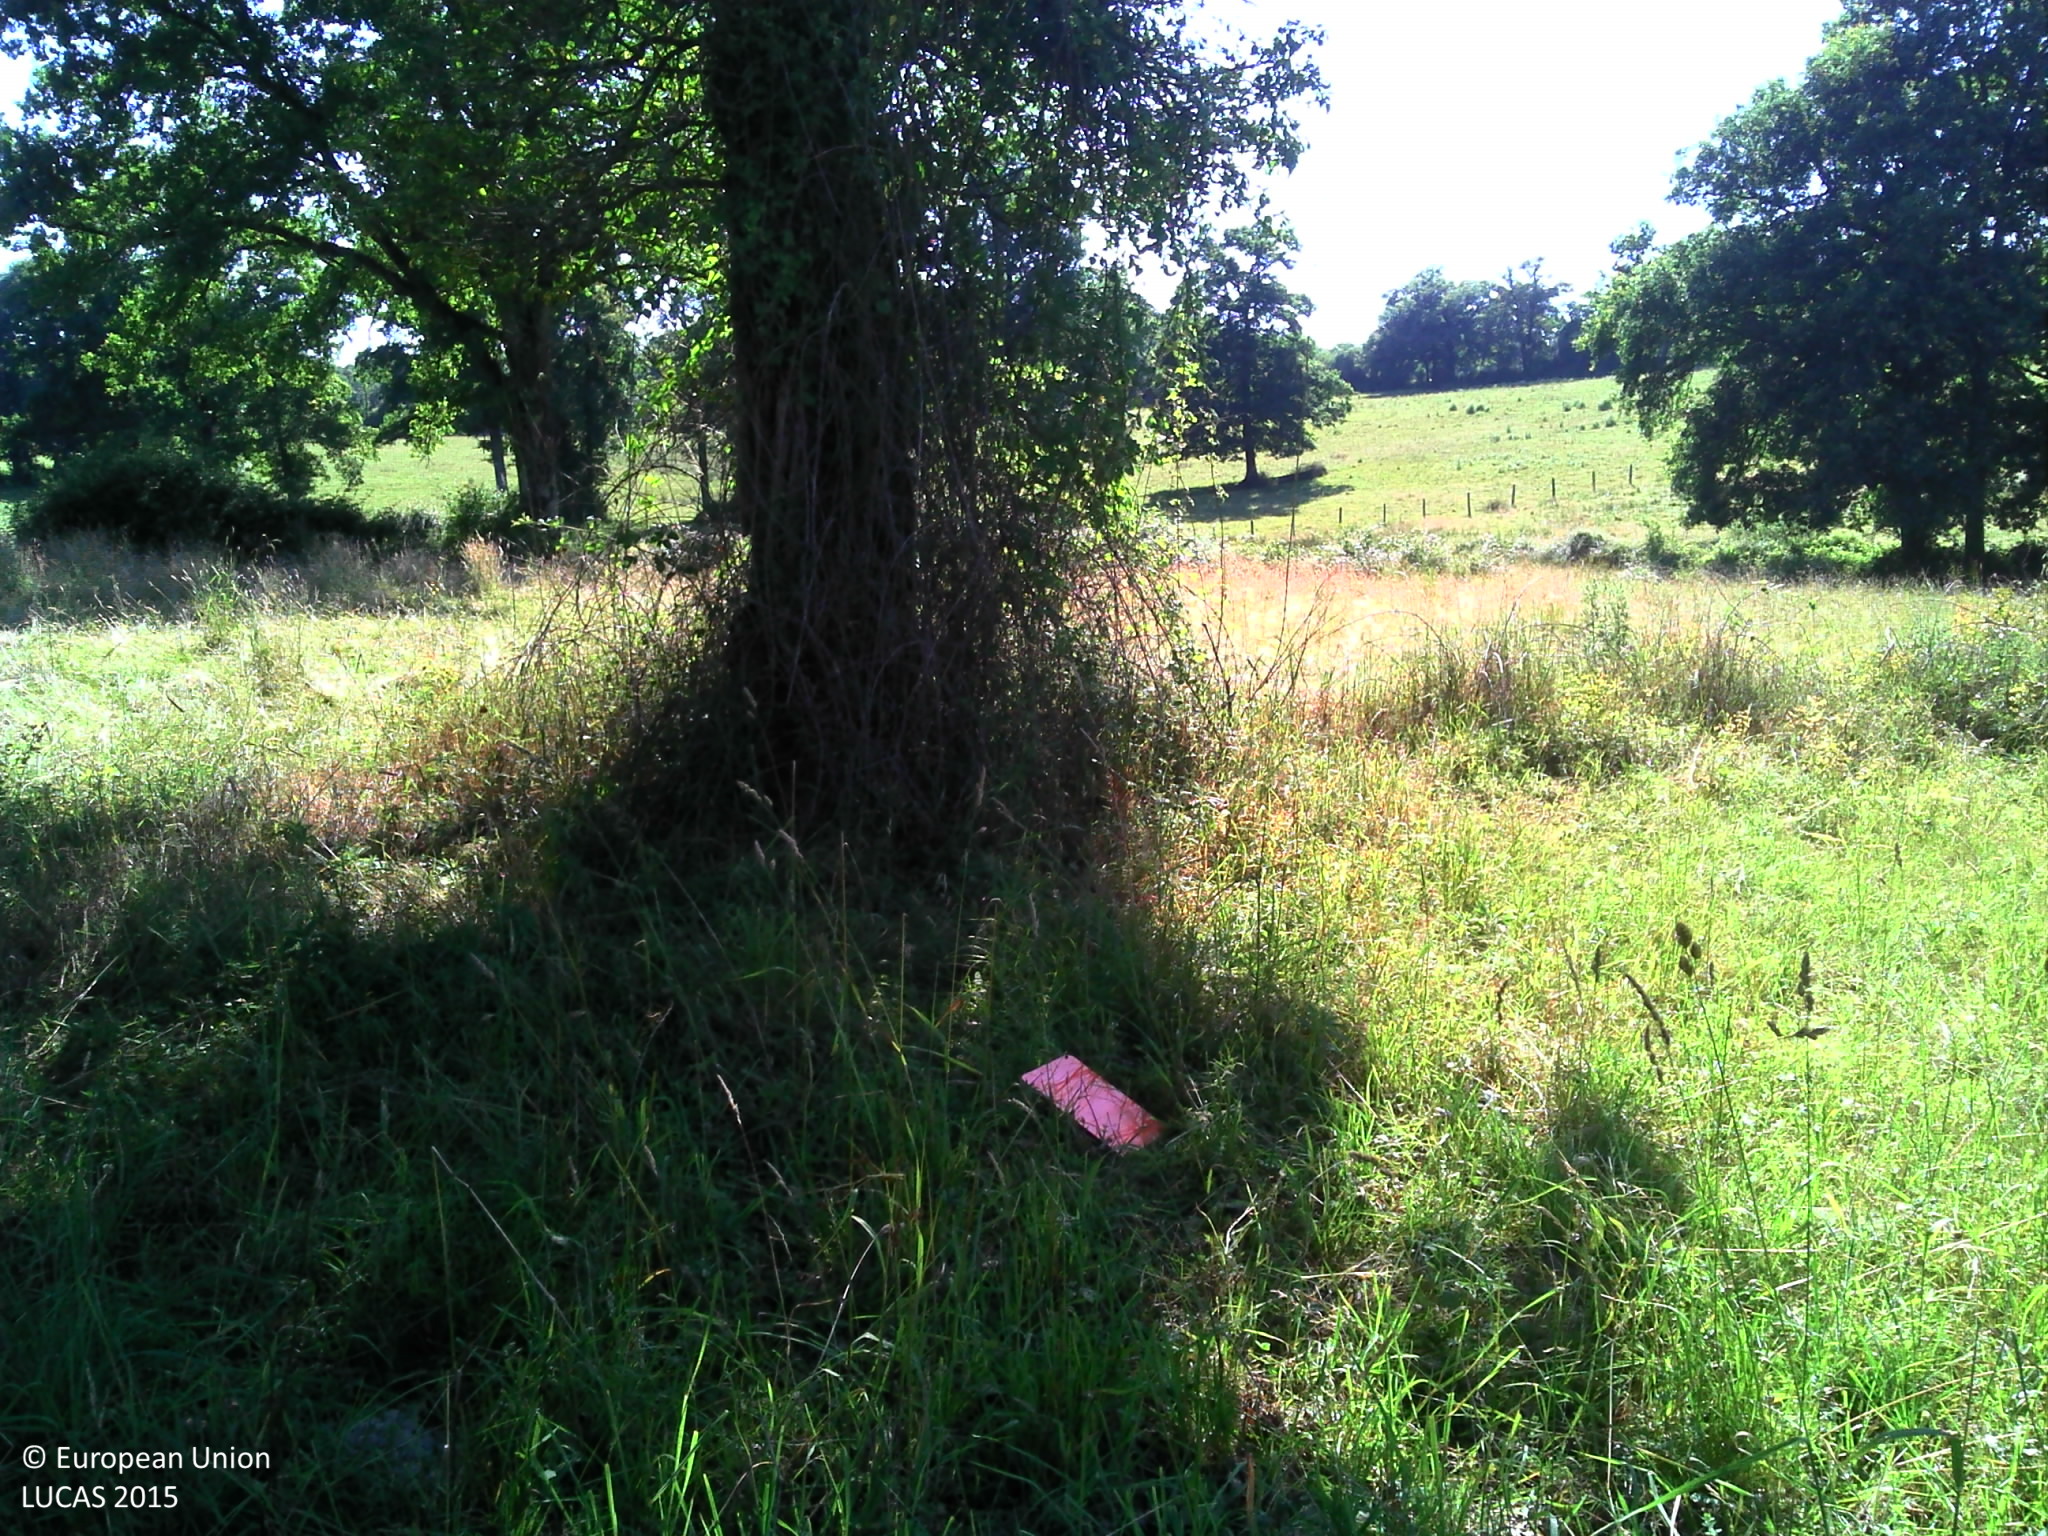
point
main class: Grassland
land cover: Grassland with sparse tree/shrub cover
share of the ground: > 75 %
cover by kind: herbaceous plants 95 %, broadleaved forest trees 5 %
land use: Agriculture (excluding fallow land and kitchen gardens)
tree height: > 5 m
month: June
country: FR
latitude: 45.8168
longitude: 0.6819
